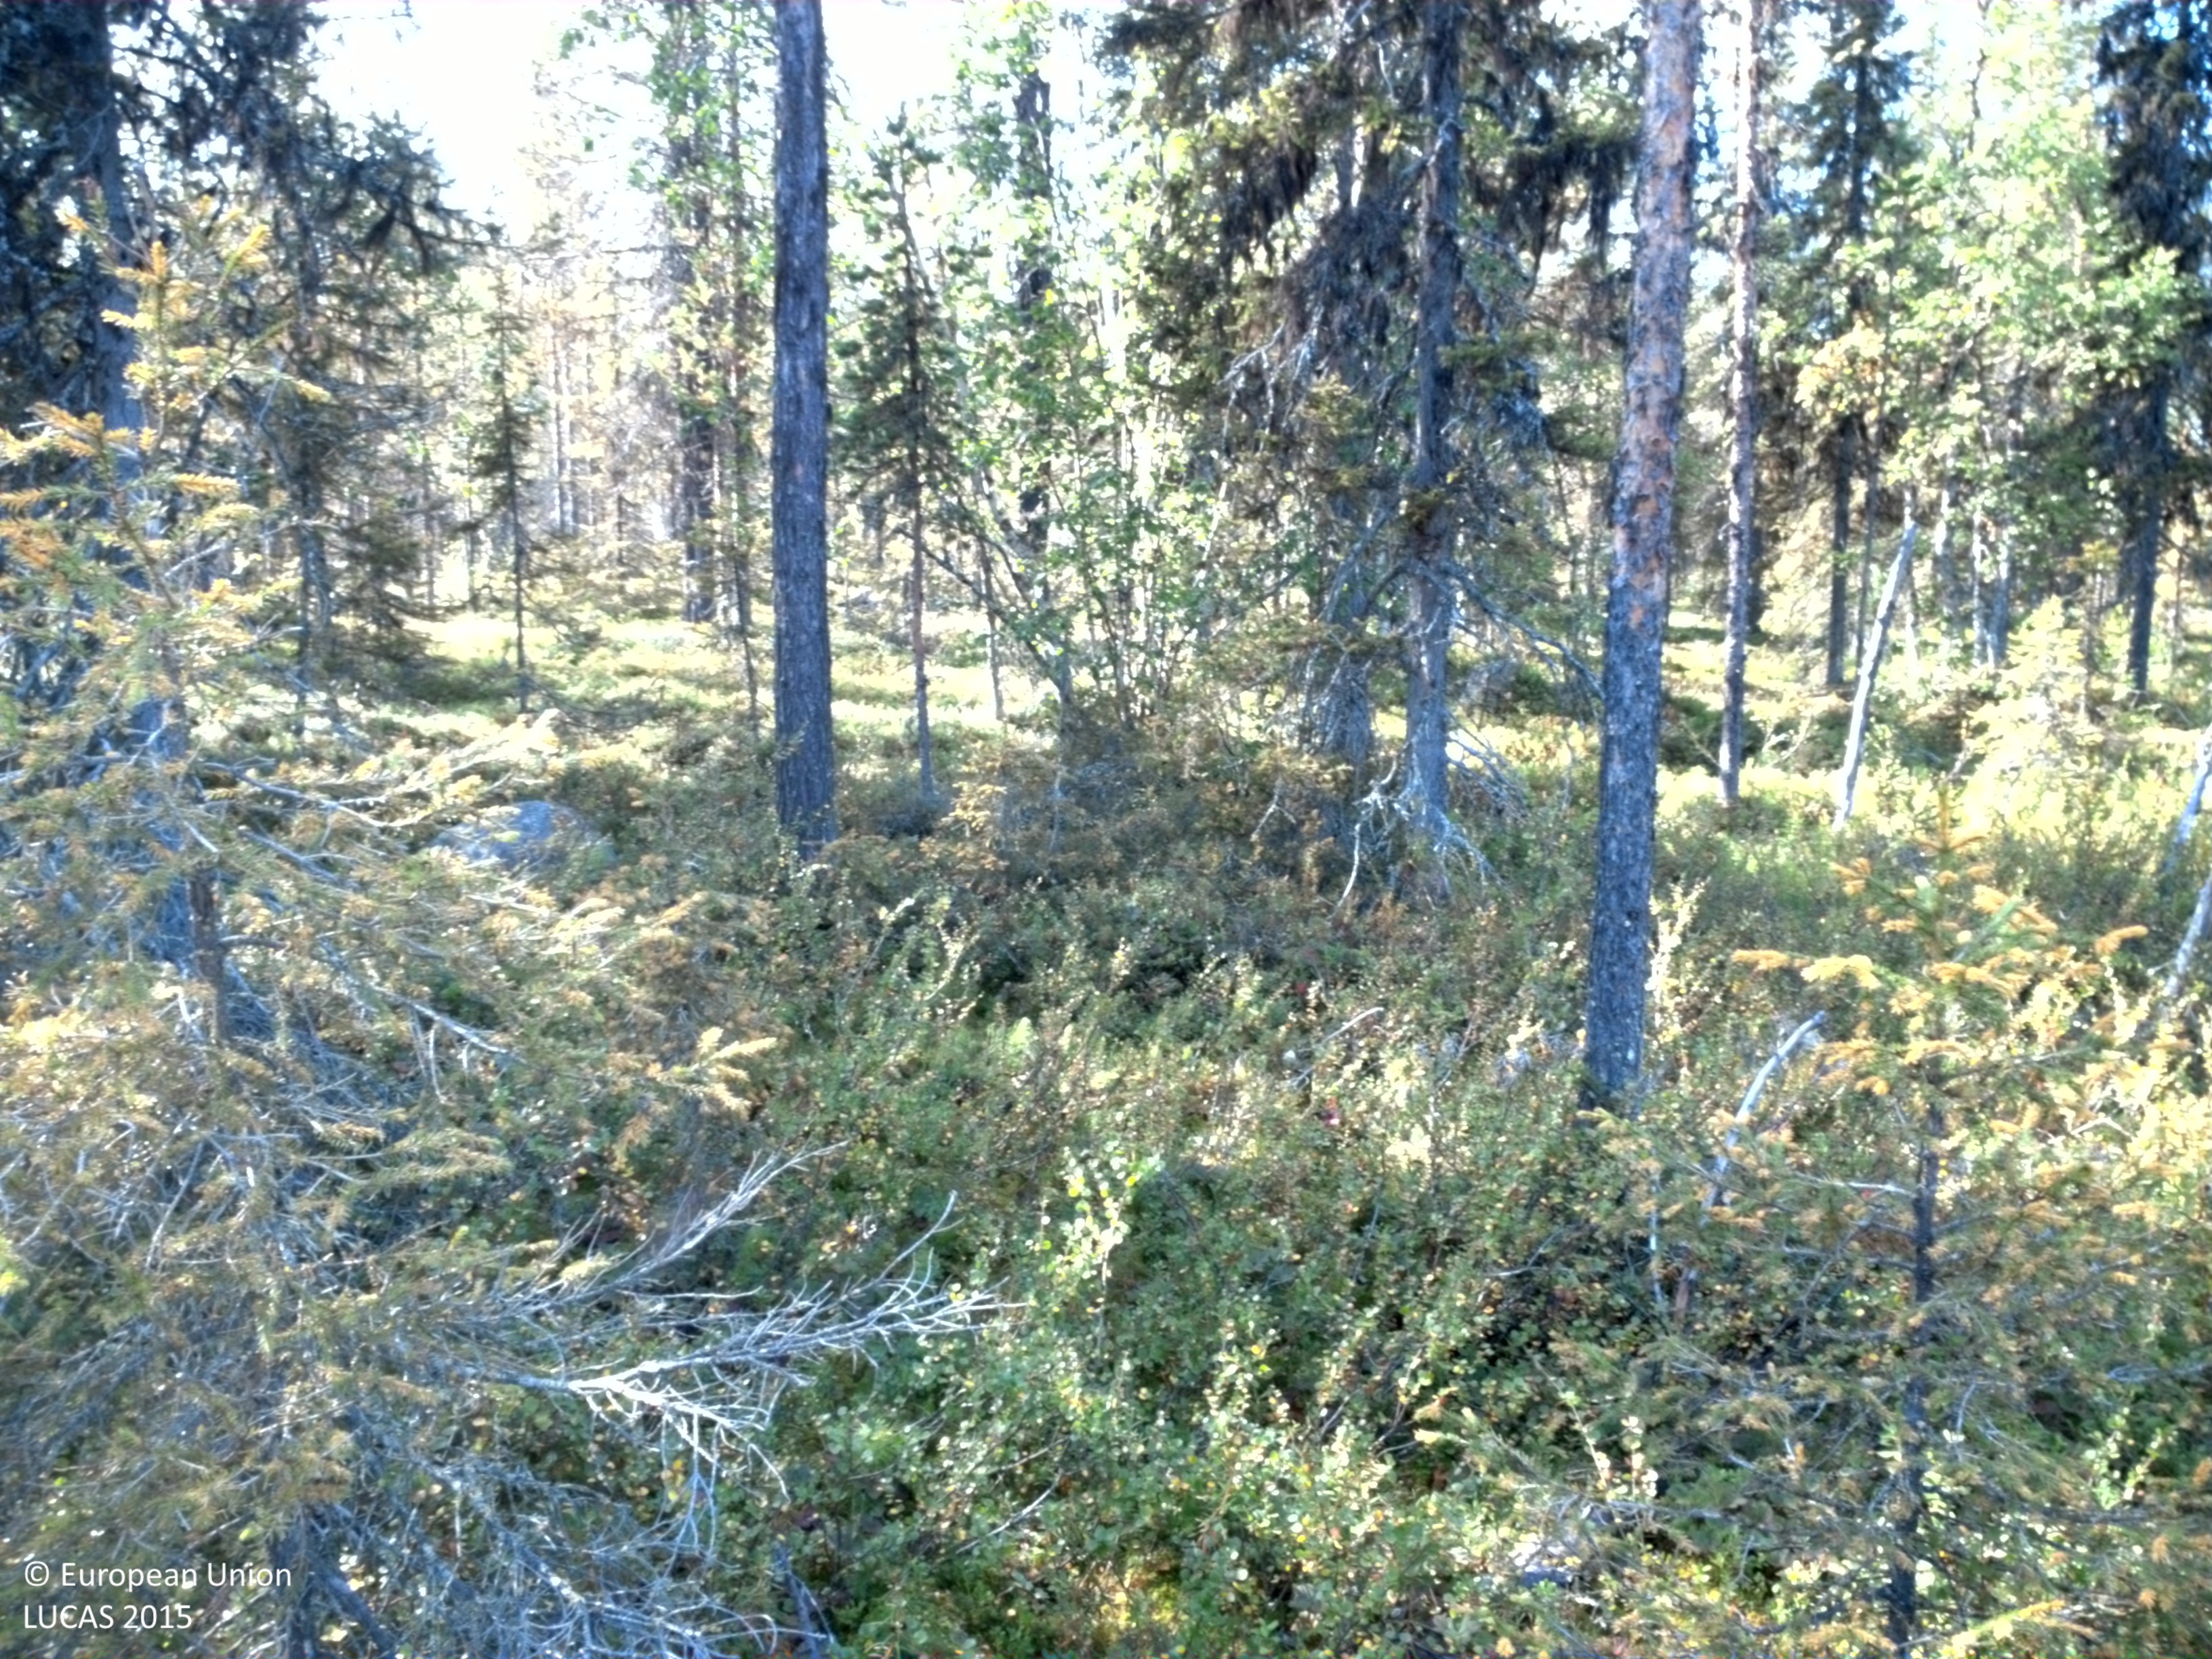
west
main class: Woodland
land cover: Spruce dominated coniferous woodland
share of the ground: 25 - 50 %
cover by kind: shrubs 75 %, coniferous forest trees 25 %
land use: Forestry
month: August
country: SE
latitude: 66.7690
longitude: 20.8374
